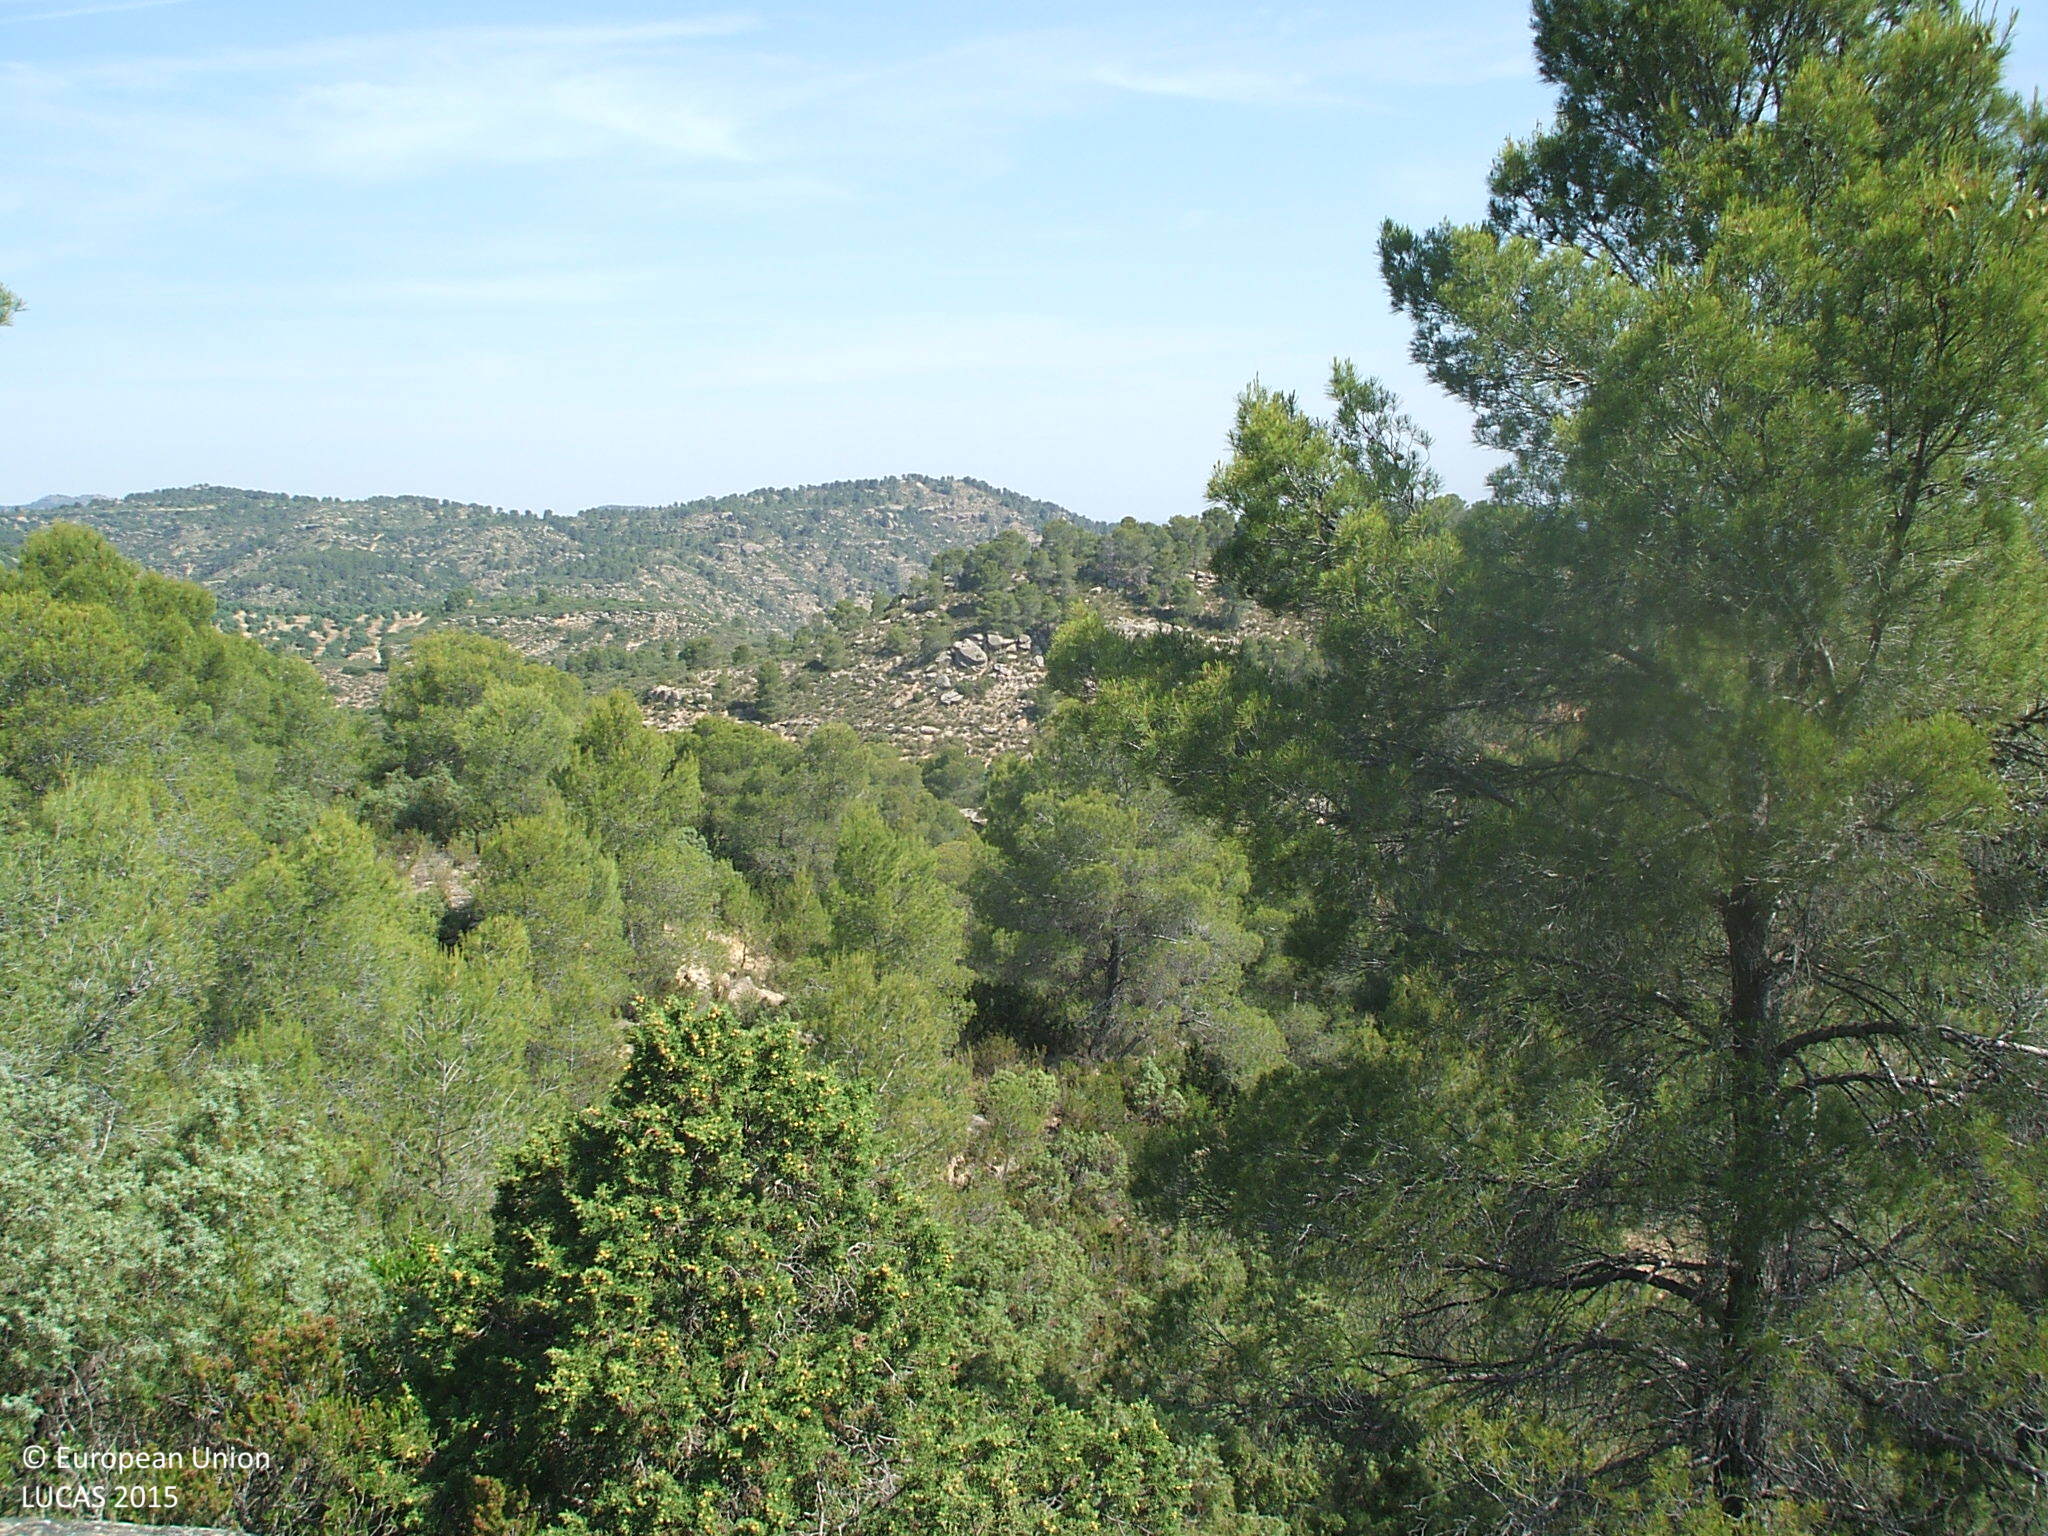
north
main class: Woodland
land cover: Pine dominated coniferous woodland
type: coniferous forest of the mediterranean region
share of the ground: > 75 %
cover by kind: coniferous forest trees 100 %
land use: Semi-natural and natural areas not in use
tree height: > 5 m
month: June
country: ES
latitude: 41.0343
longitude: 0.2251
